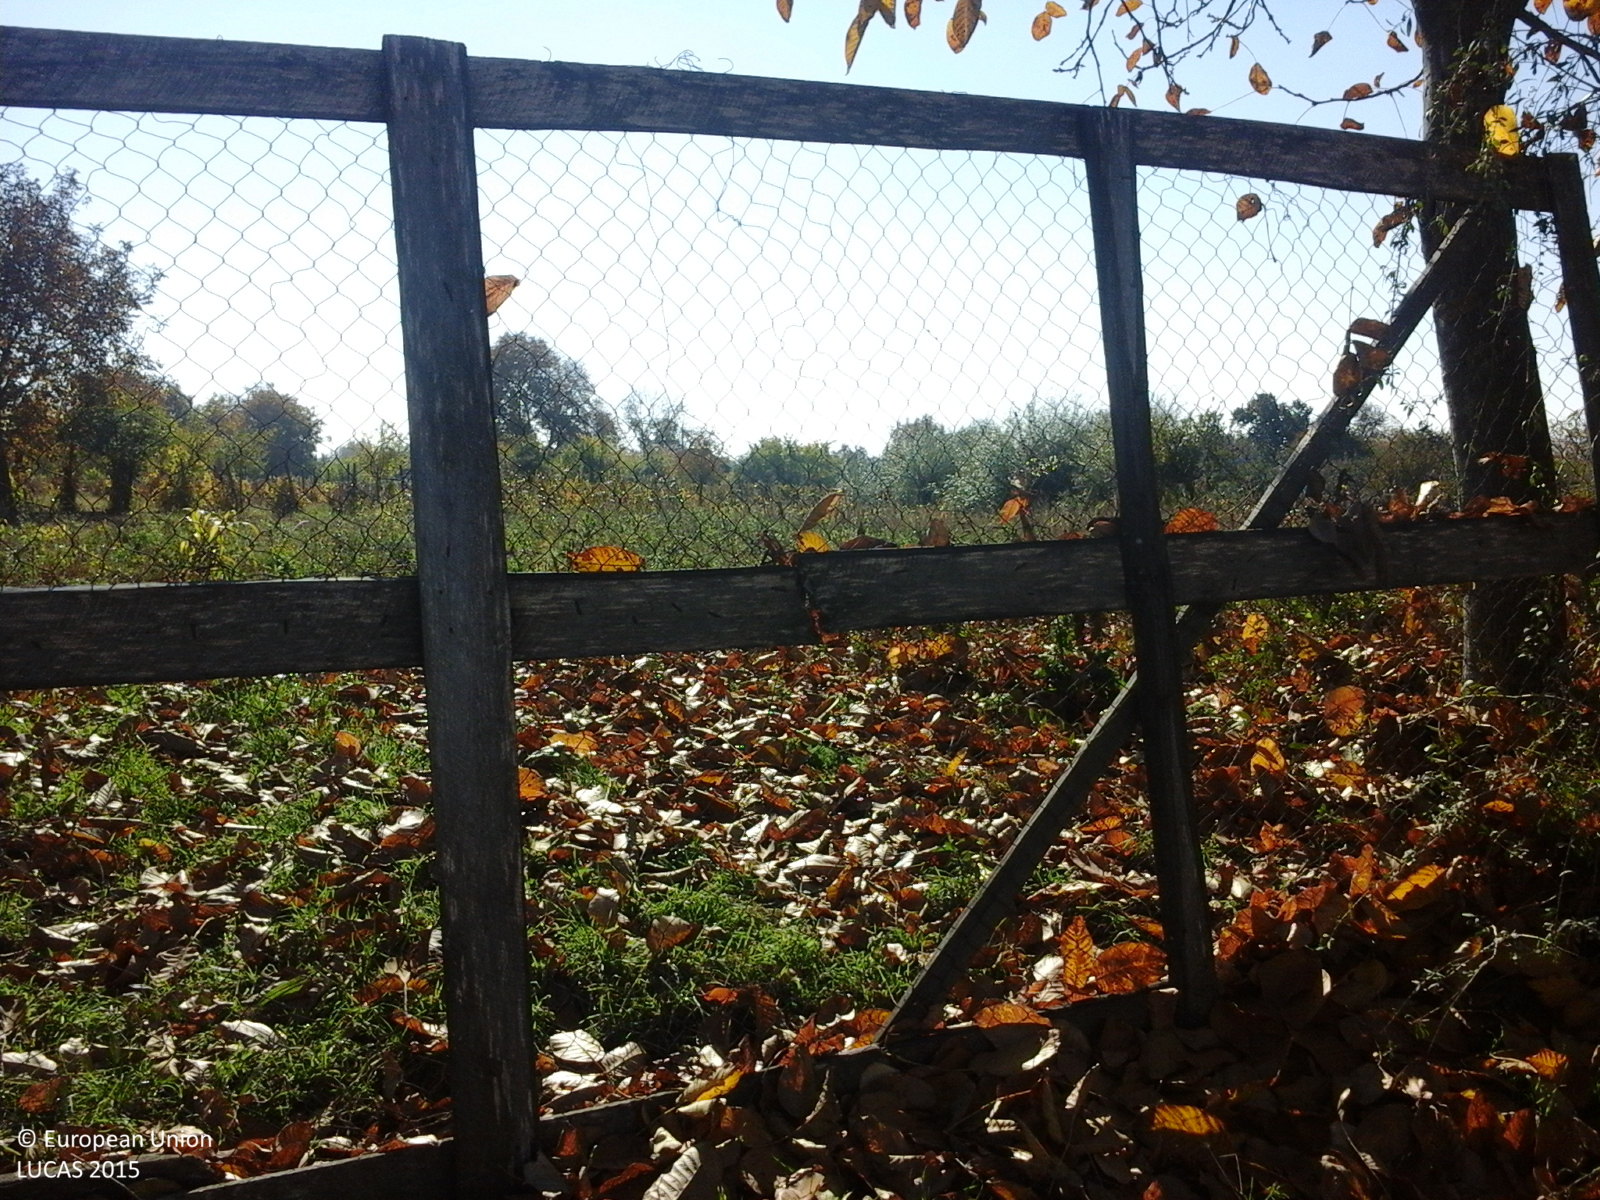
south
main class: Grassland
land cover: Spontaneously vegetated surfaces
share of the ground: > 75 %
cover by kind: herbaceous plants 100 %
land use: Fallow land
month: October
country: RO
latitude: 45.9524
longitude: 27.1118
